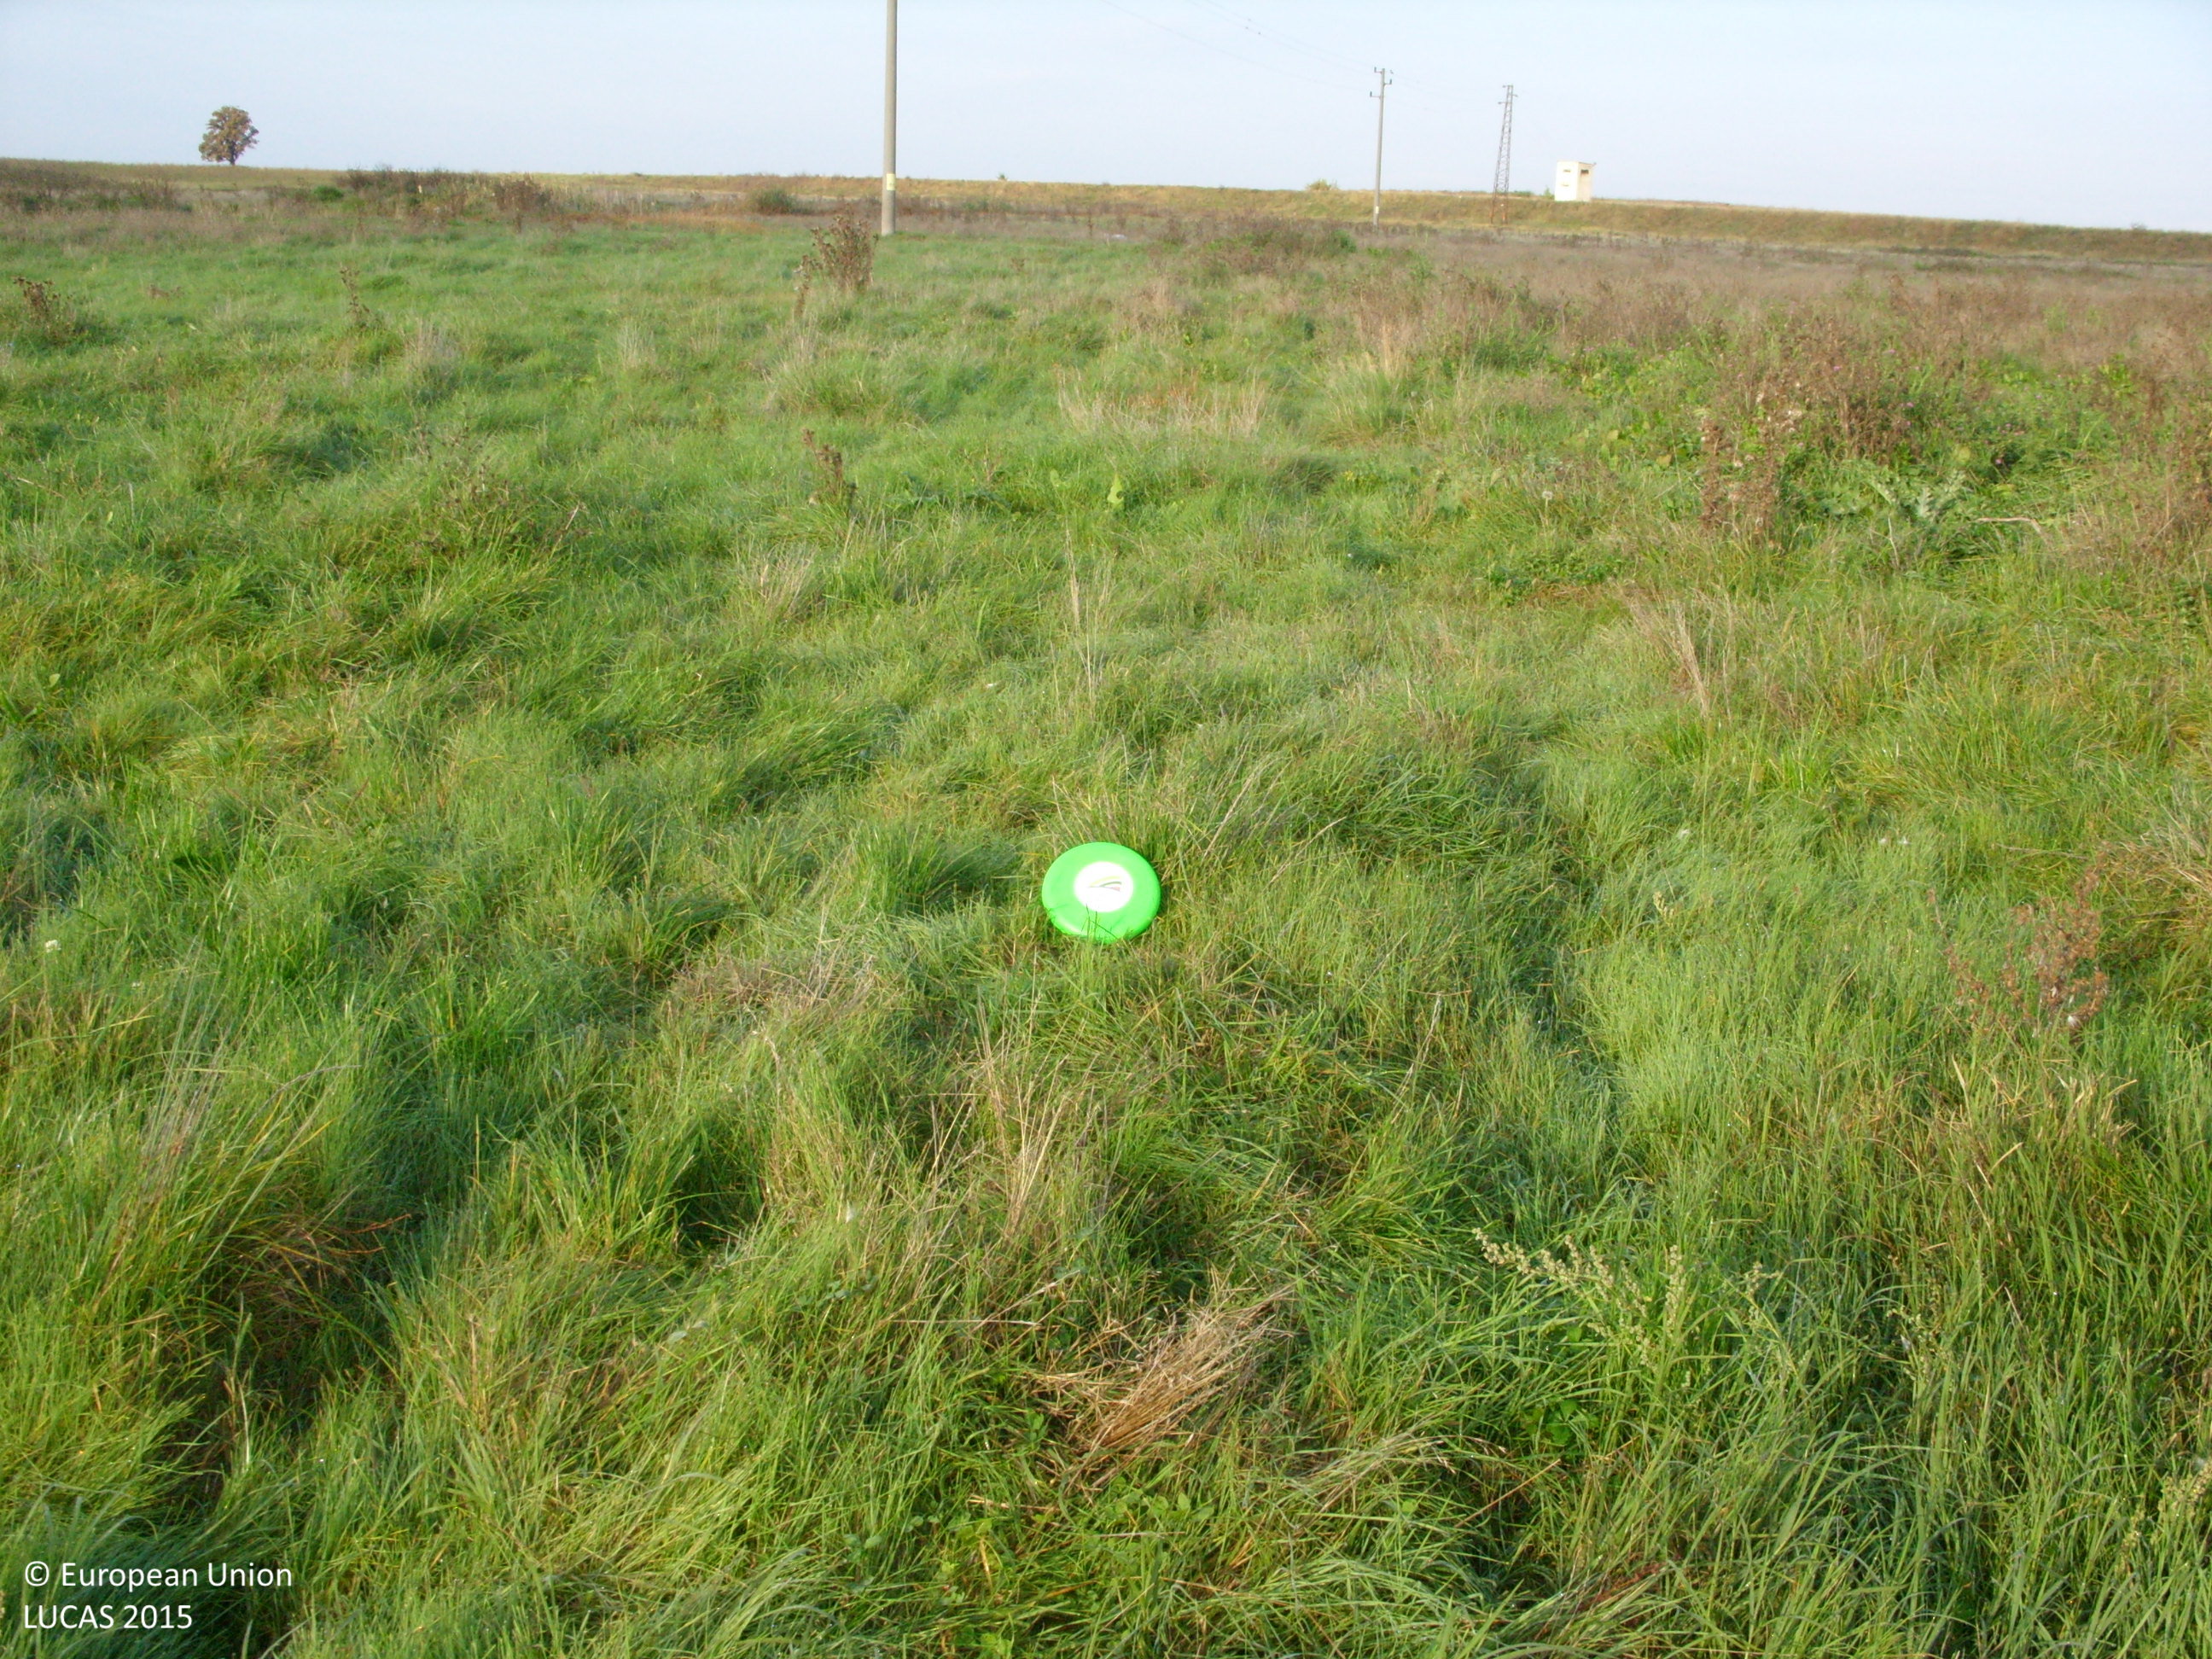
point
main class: Grassland
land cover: Grassland without tree/shrub cover
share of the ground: > 75 %
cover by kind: herbaceous plants 100 %
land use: Agriculture (excluding fallow land and kitchen gardens)
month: October
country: BG
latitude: 42.3827
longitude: 24.6888
